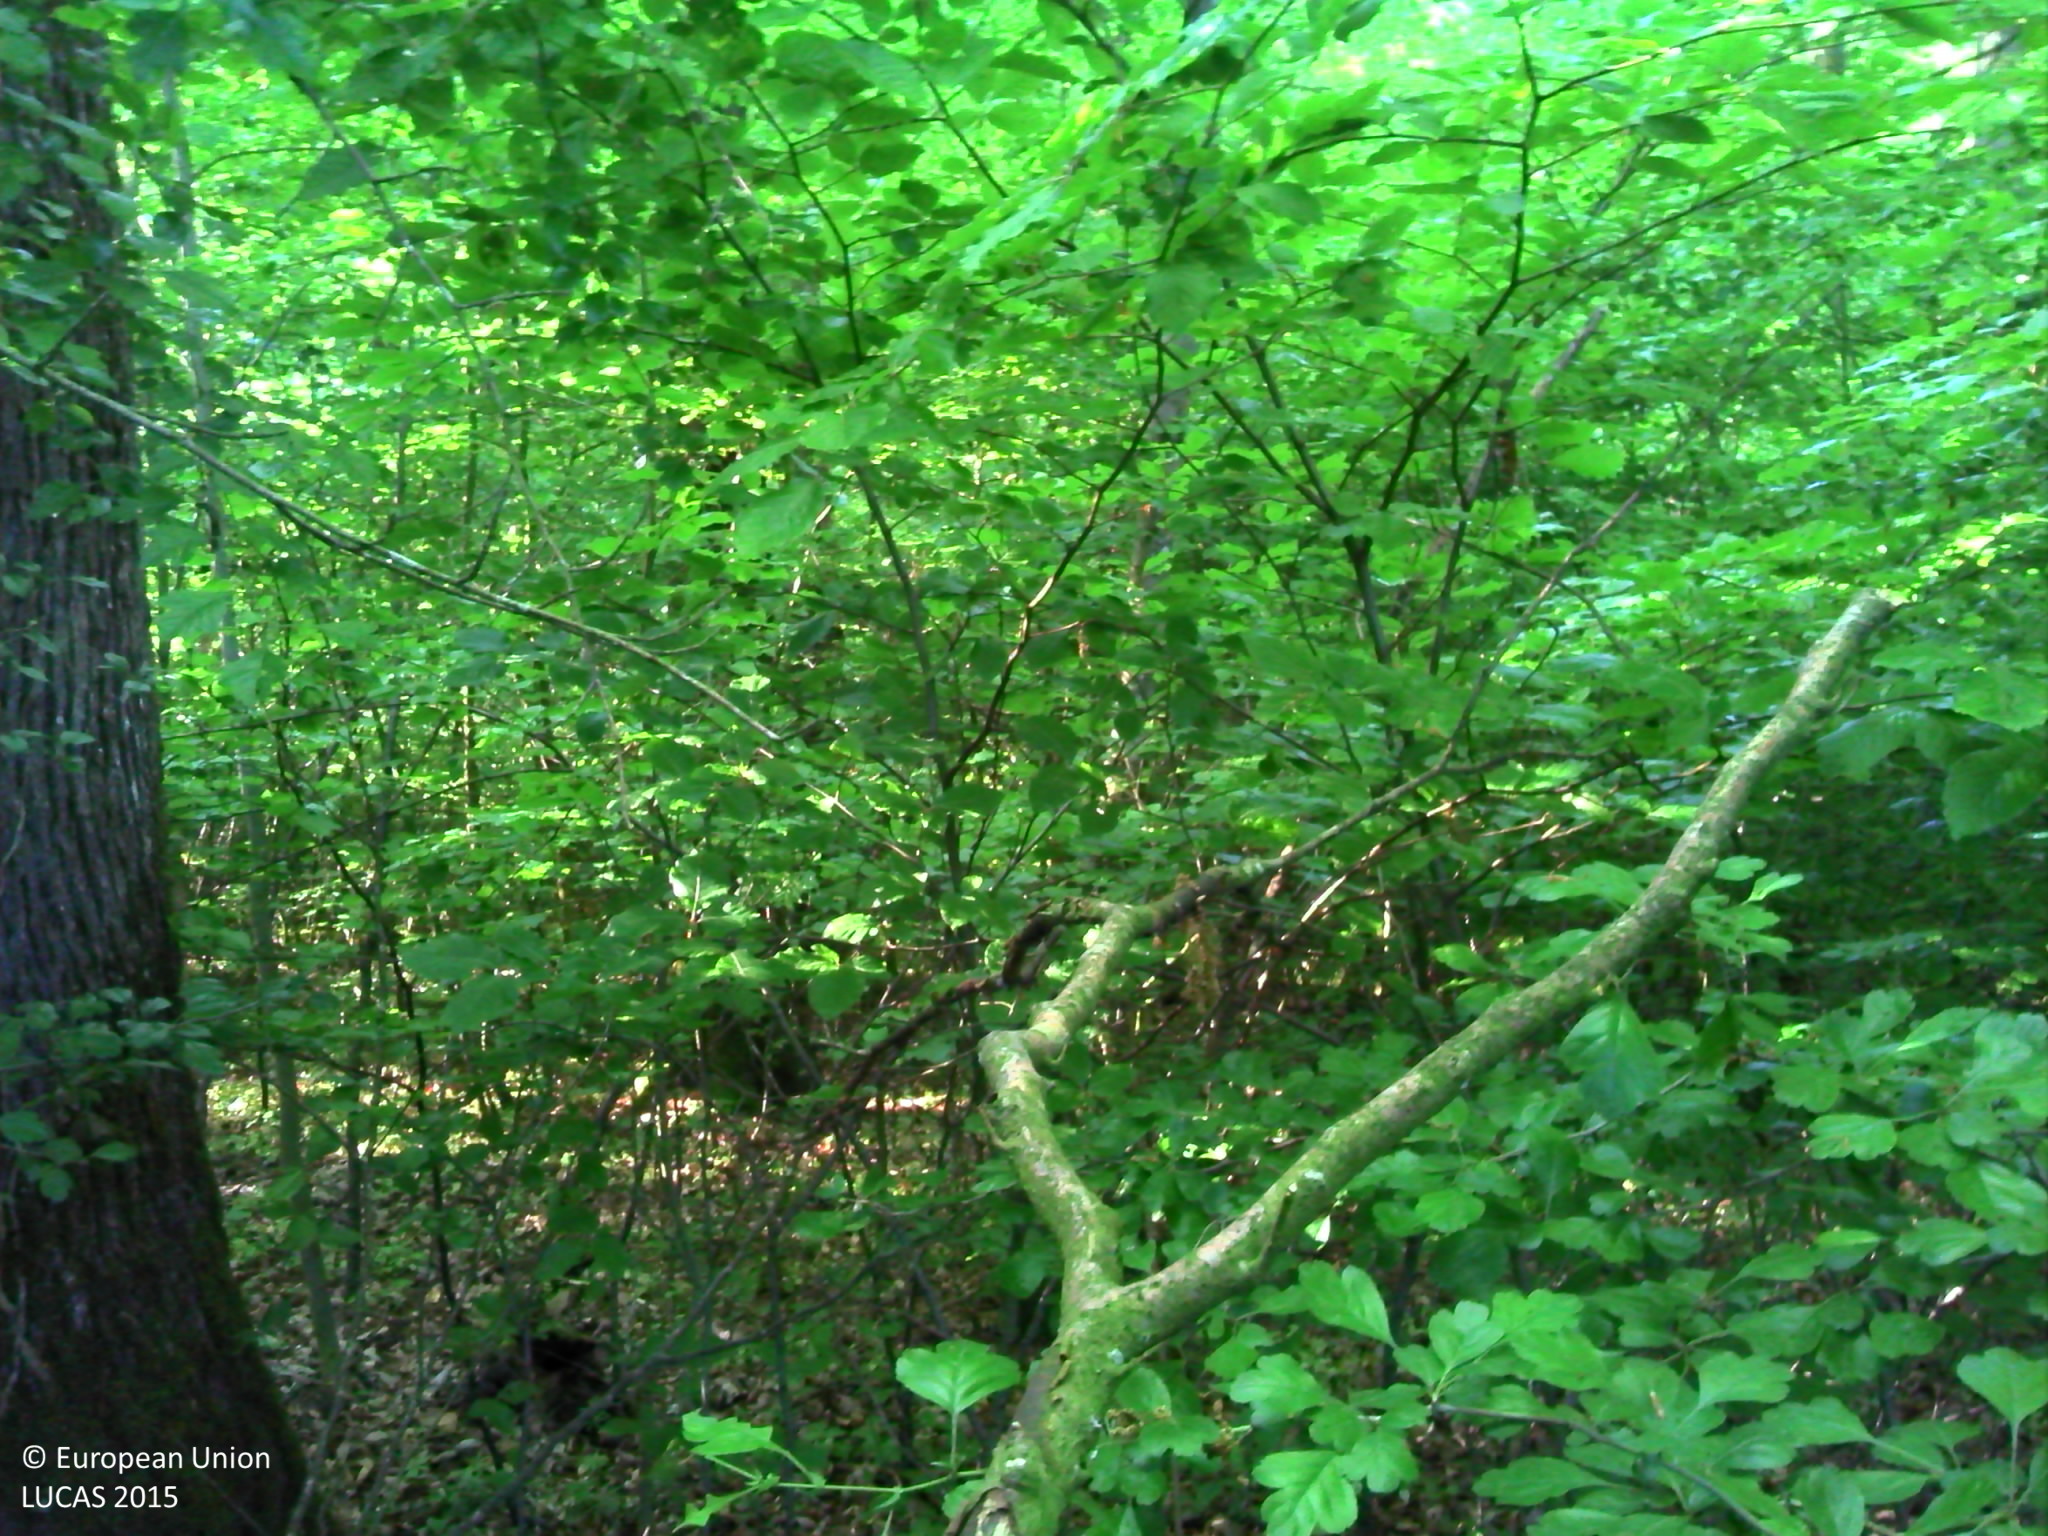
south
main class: Woodland
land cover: Broadleaved woodland
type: mesophytic deciduous forest
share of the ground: > 75 %
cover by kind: broadleaved forest trees 90 %, herbaceous plants 5 %, lichens and mosses 5 %
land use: Forestry
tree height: > 5 m
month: May
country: LU
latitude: 49.6409
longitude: 6.3854
